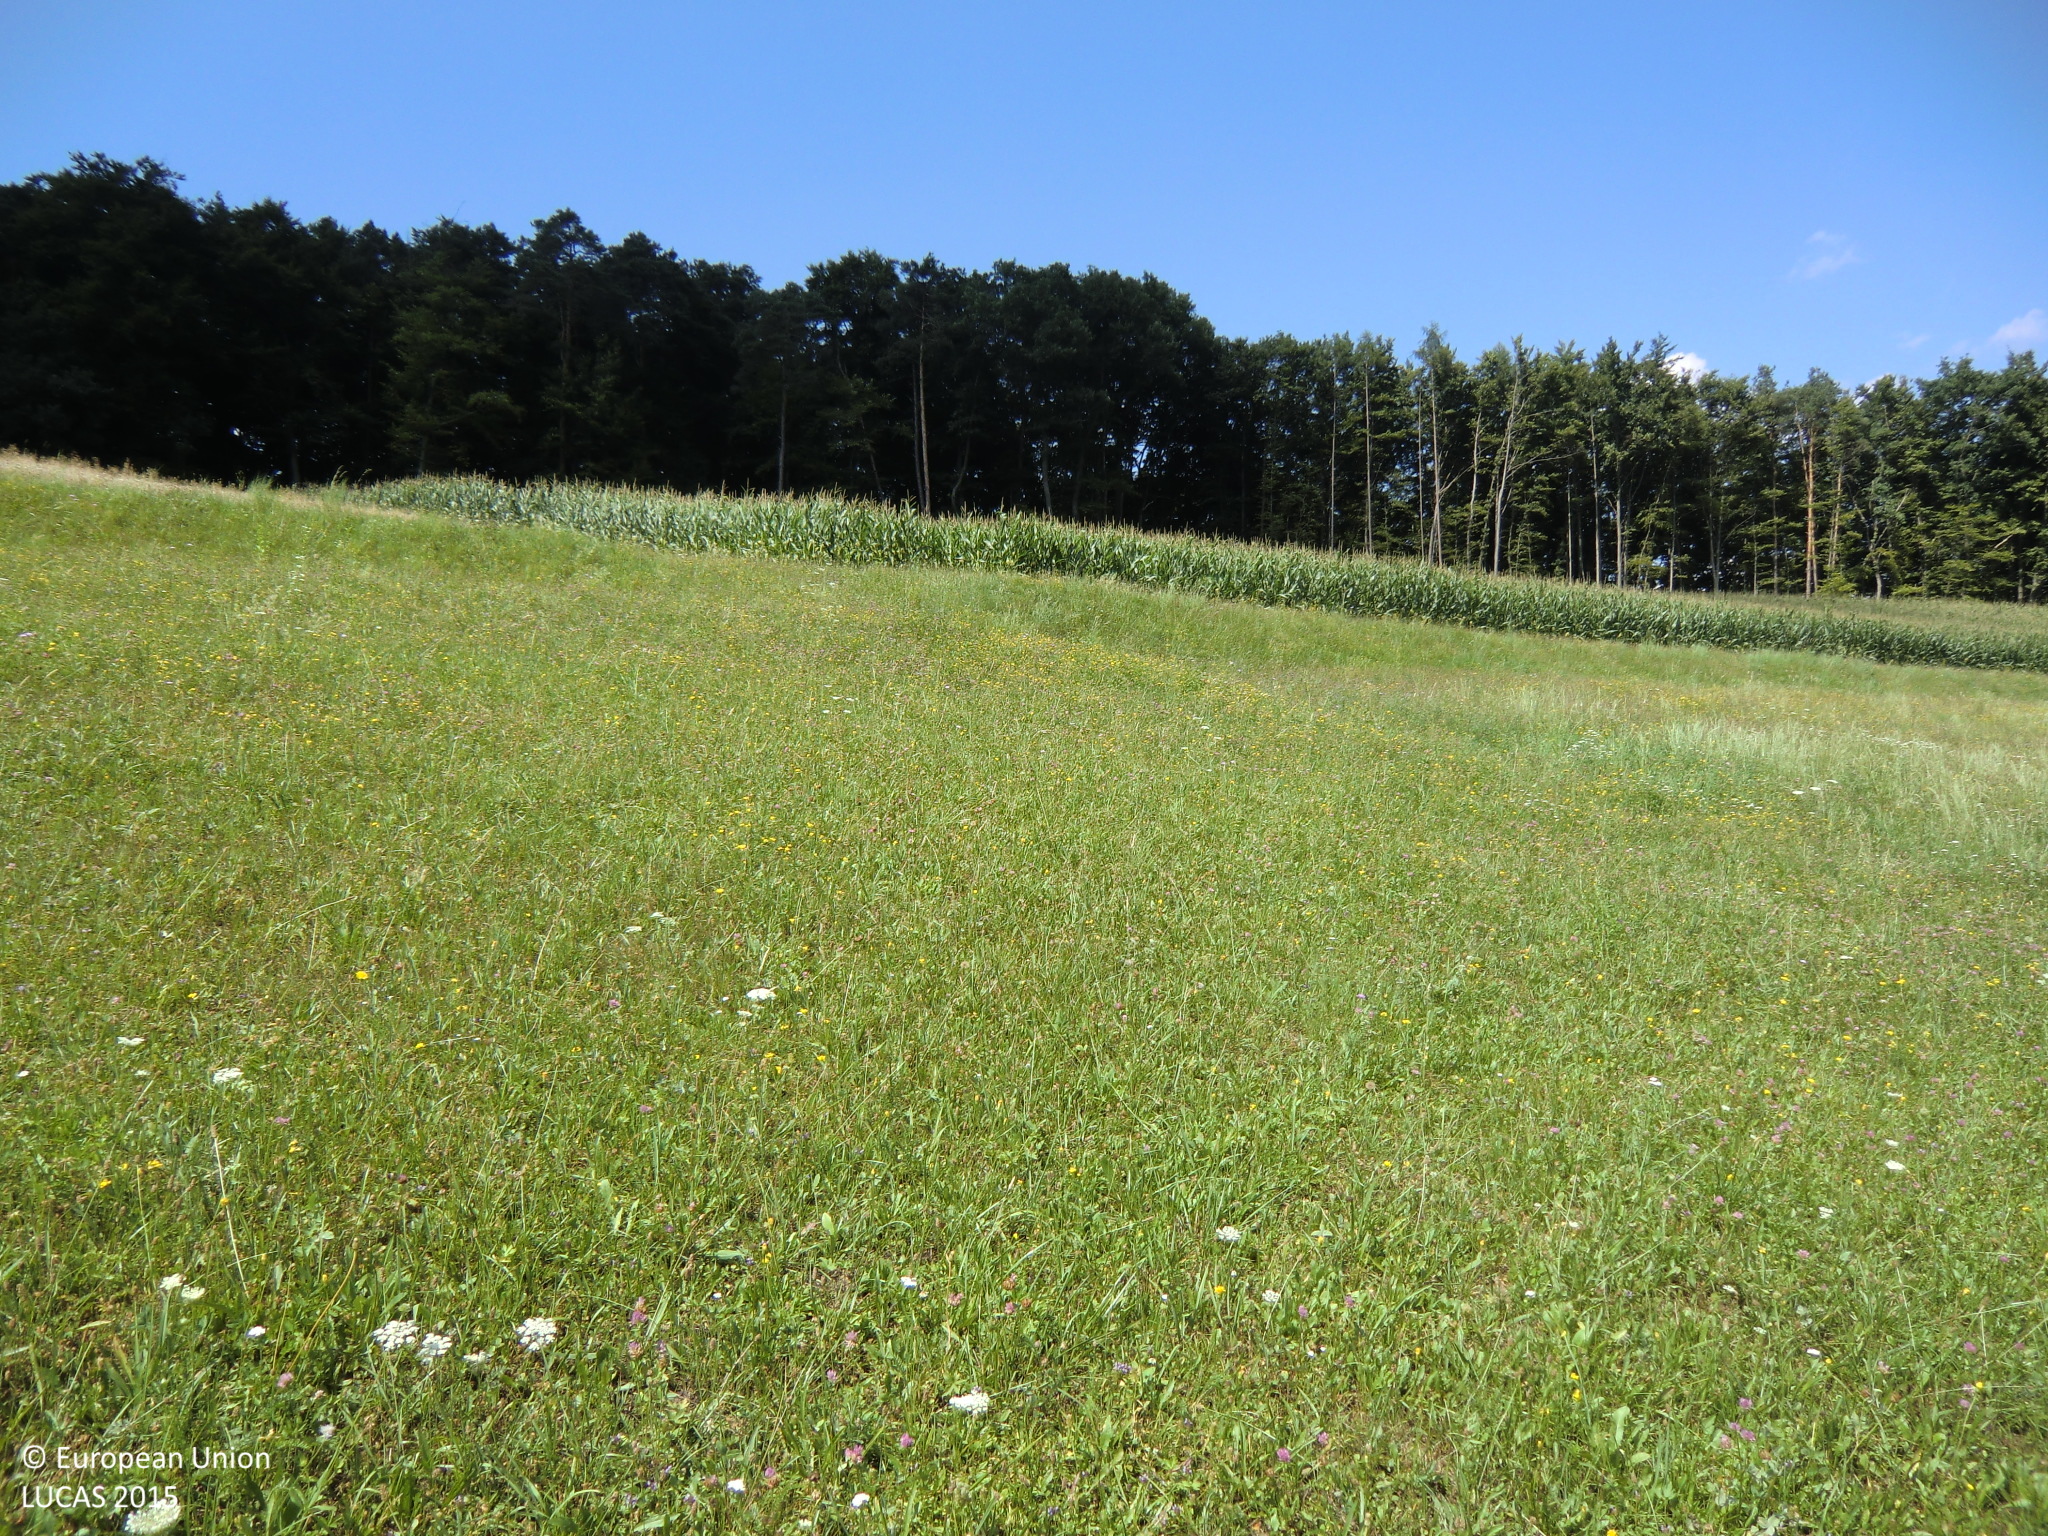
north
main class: Grassland
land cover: Grassland without tree/shrub cover
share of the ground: > 75 %
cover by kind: herbaceous plants 100 %
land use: Agriculture (excluding fallow land and kitchen gardens)
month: July
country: AT
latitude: 47.0112
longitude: 16.0388
